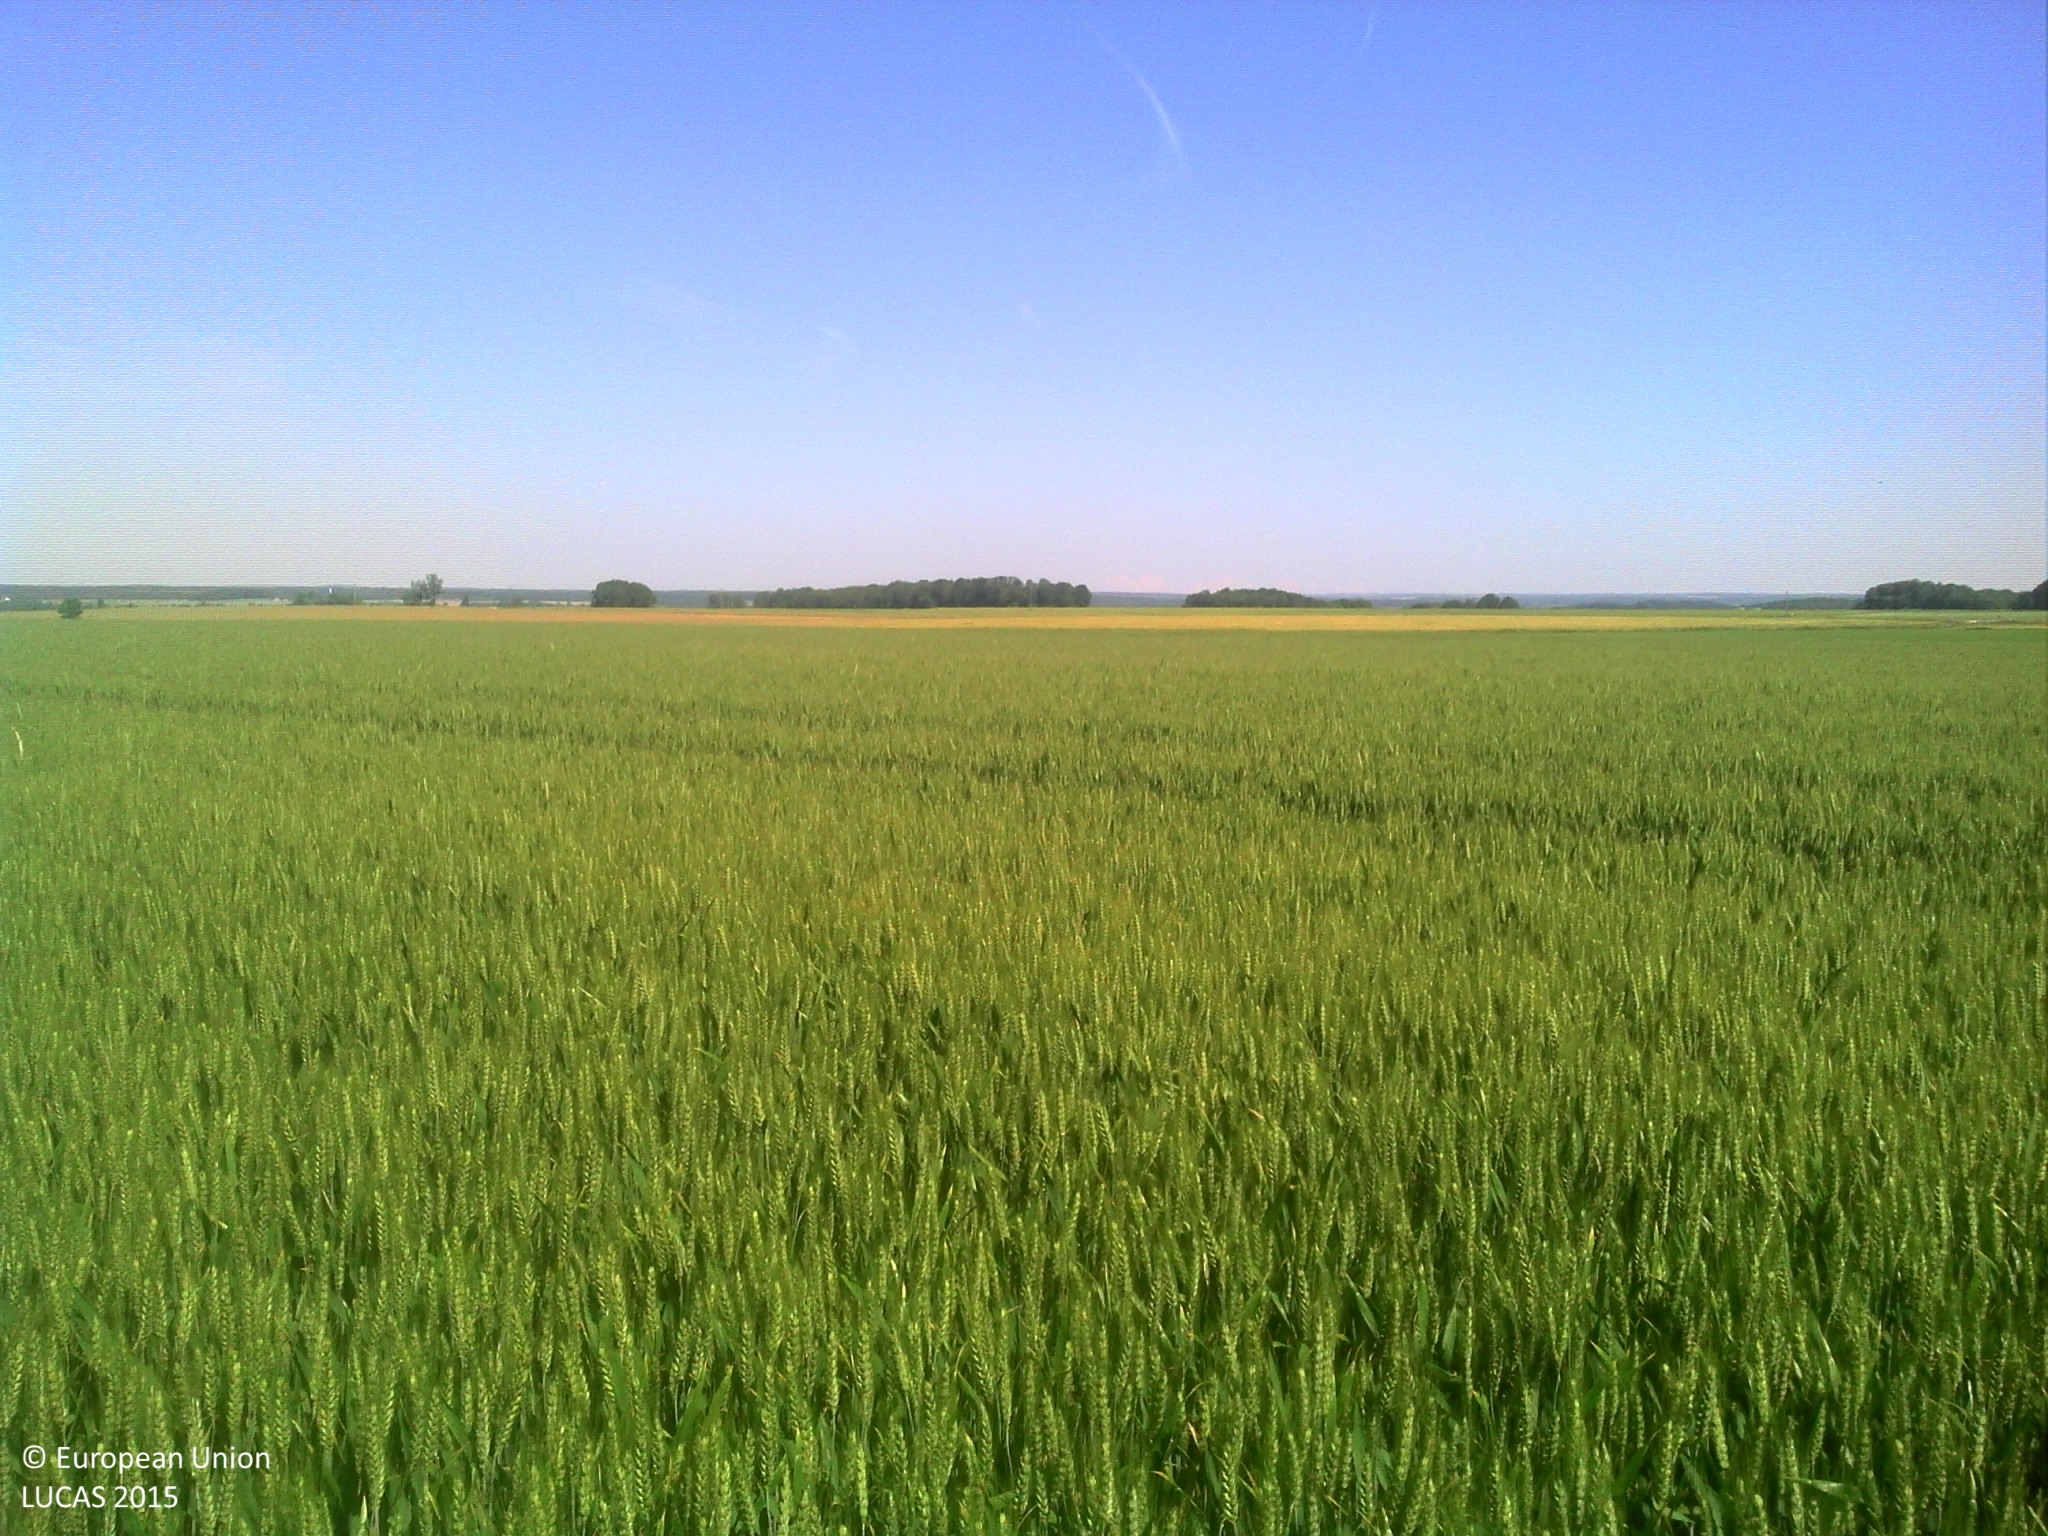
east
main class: Cropland
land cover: Common wheat
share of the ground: > 75 %
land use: Agriculture (excluding fallow land and kitchen gardens)
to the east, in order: Common wheat; Tracks; Barley
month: June
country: FR
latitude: 48.4585
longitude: 4.7376
